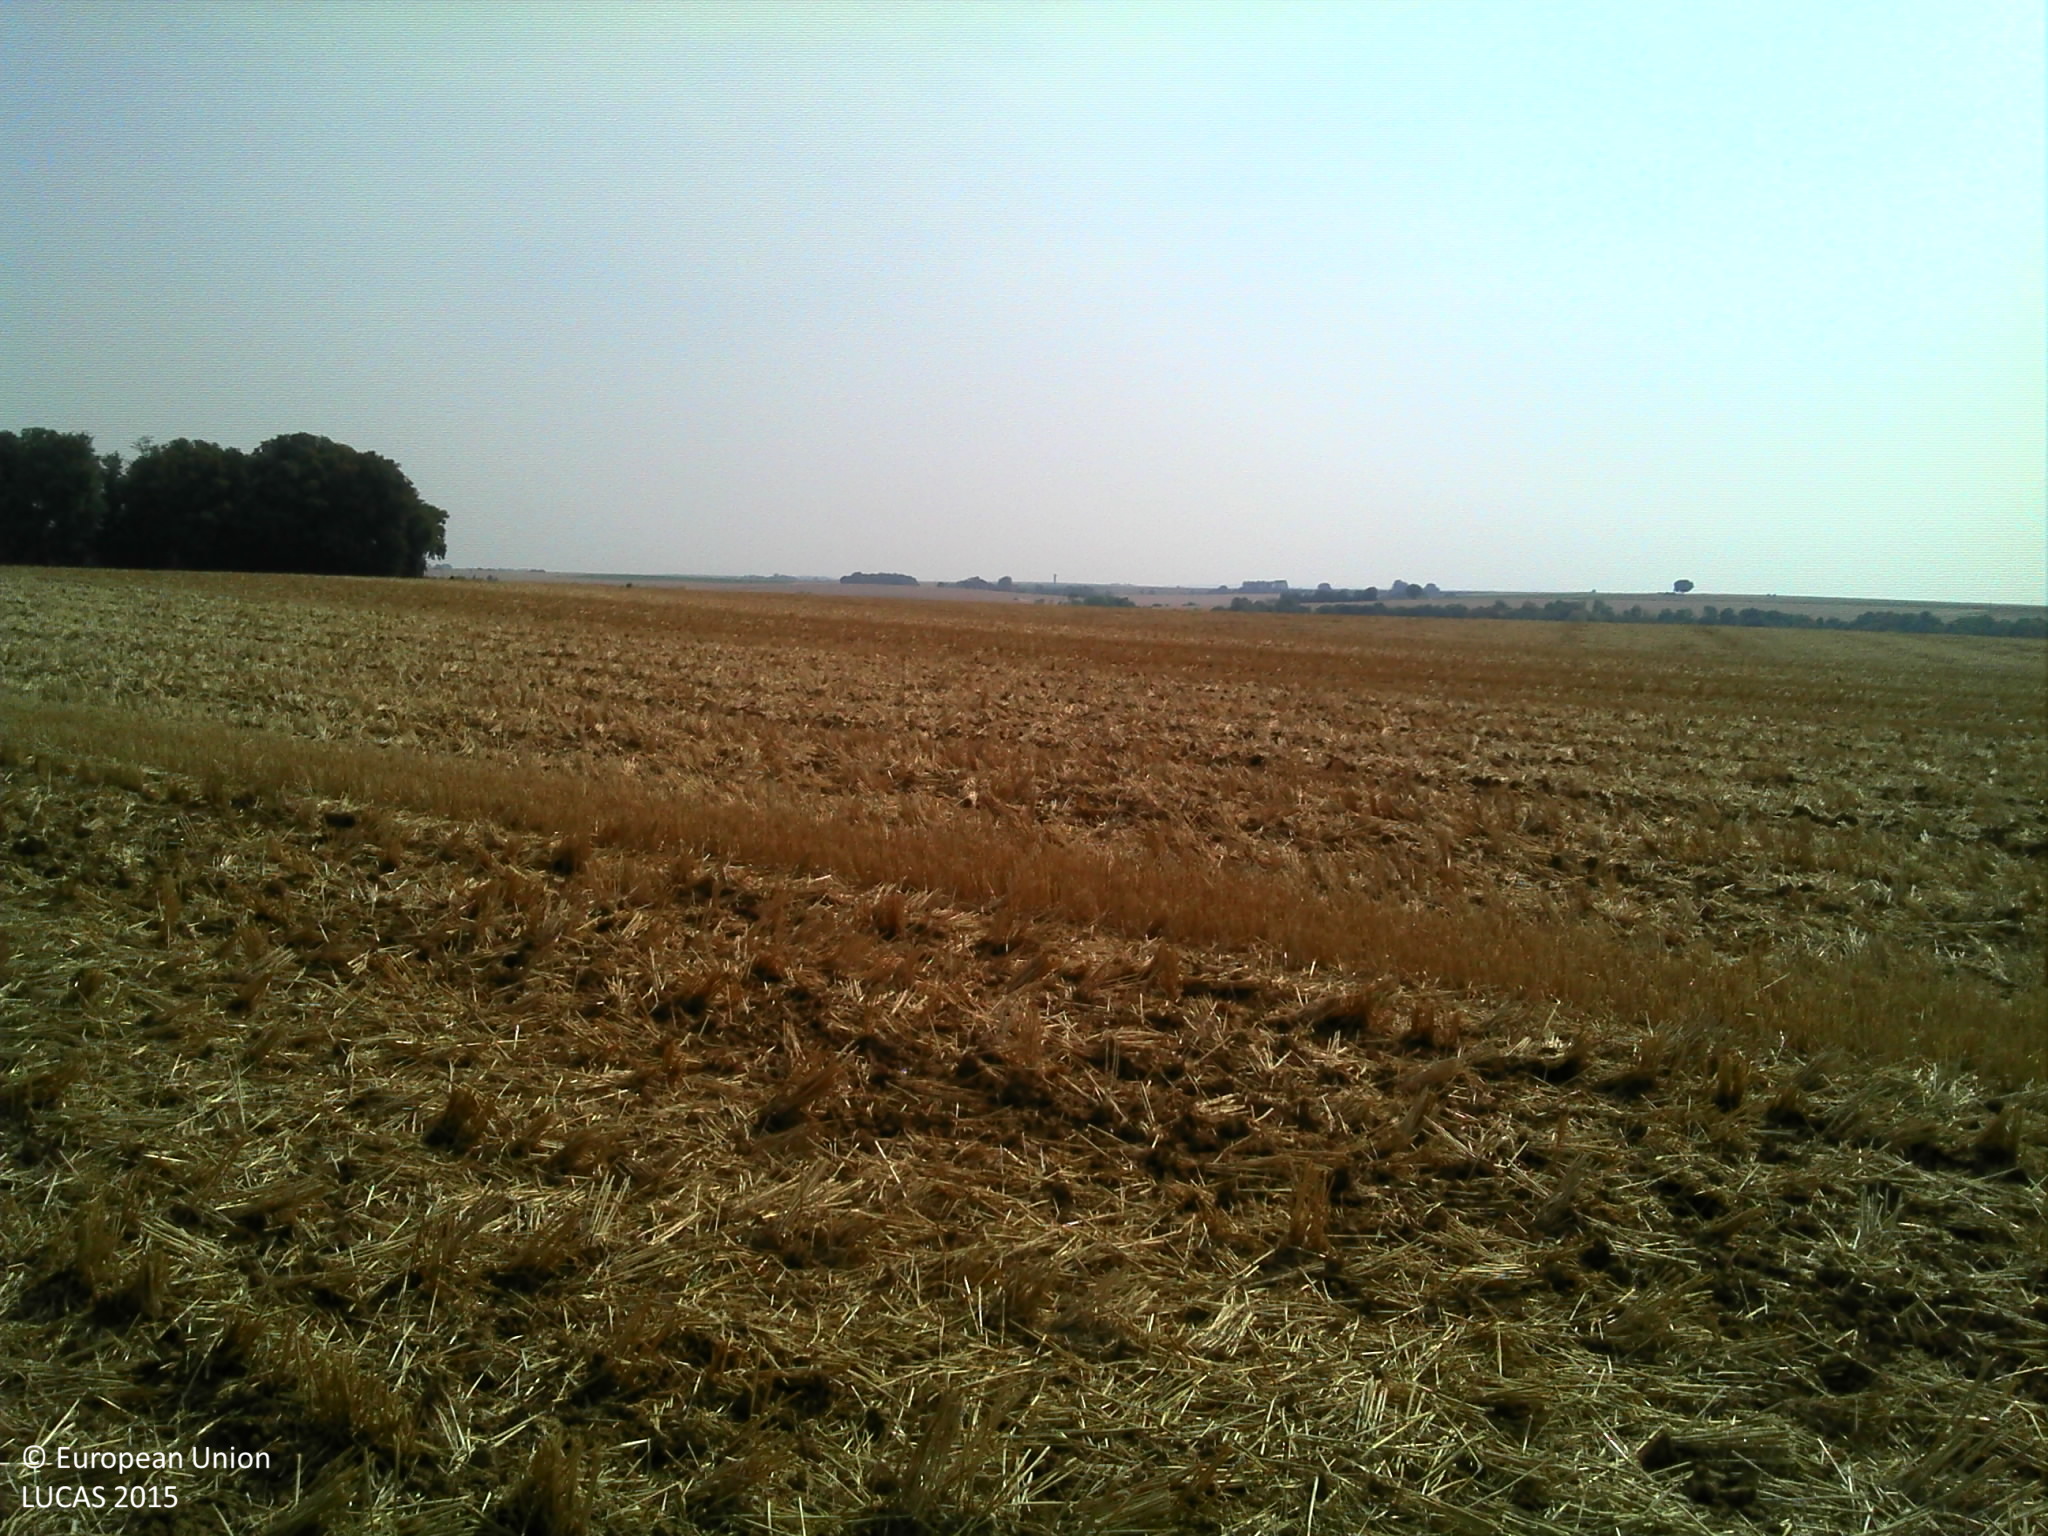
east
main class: Cropland
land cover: Common wheat
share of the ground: > 75 %
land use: Agriculture (excluding fallow land and kitchen gardens)
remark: Harvested field
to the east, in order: Common wheat
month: August
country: FR
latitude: 49.0593
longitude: 2.8879
